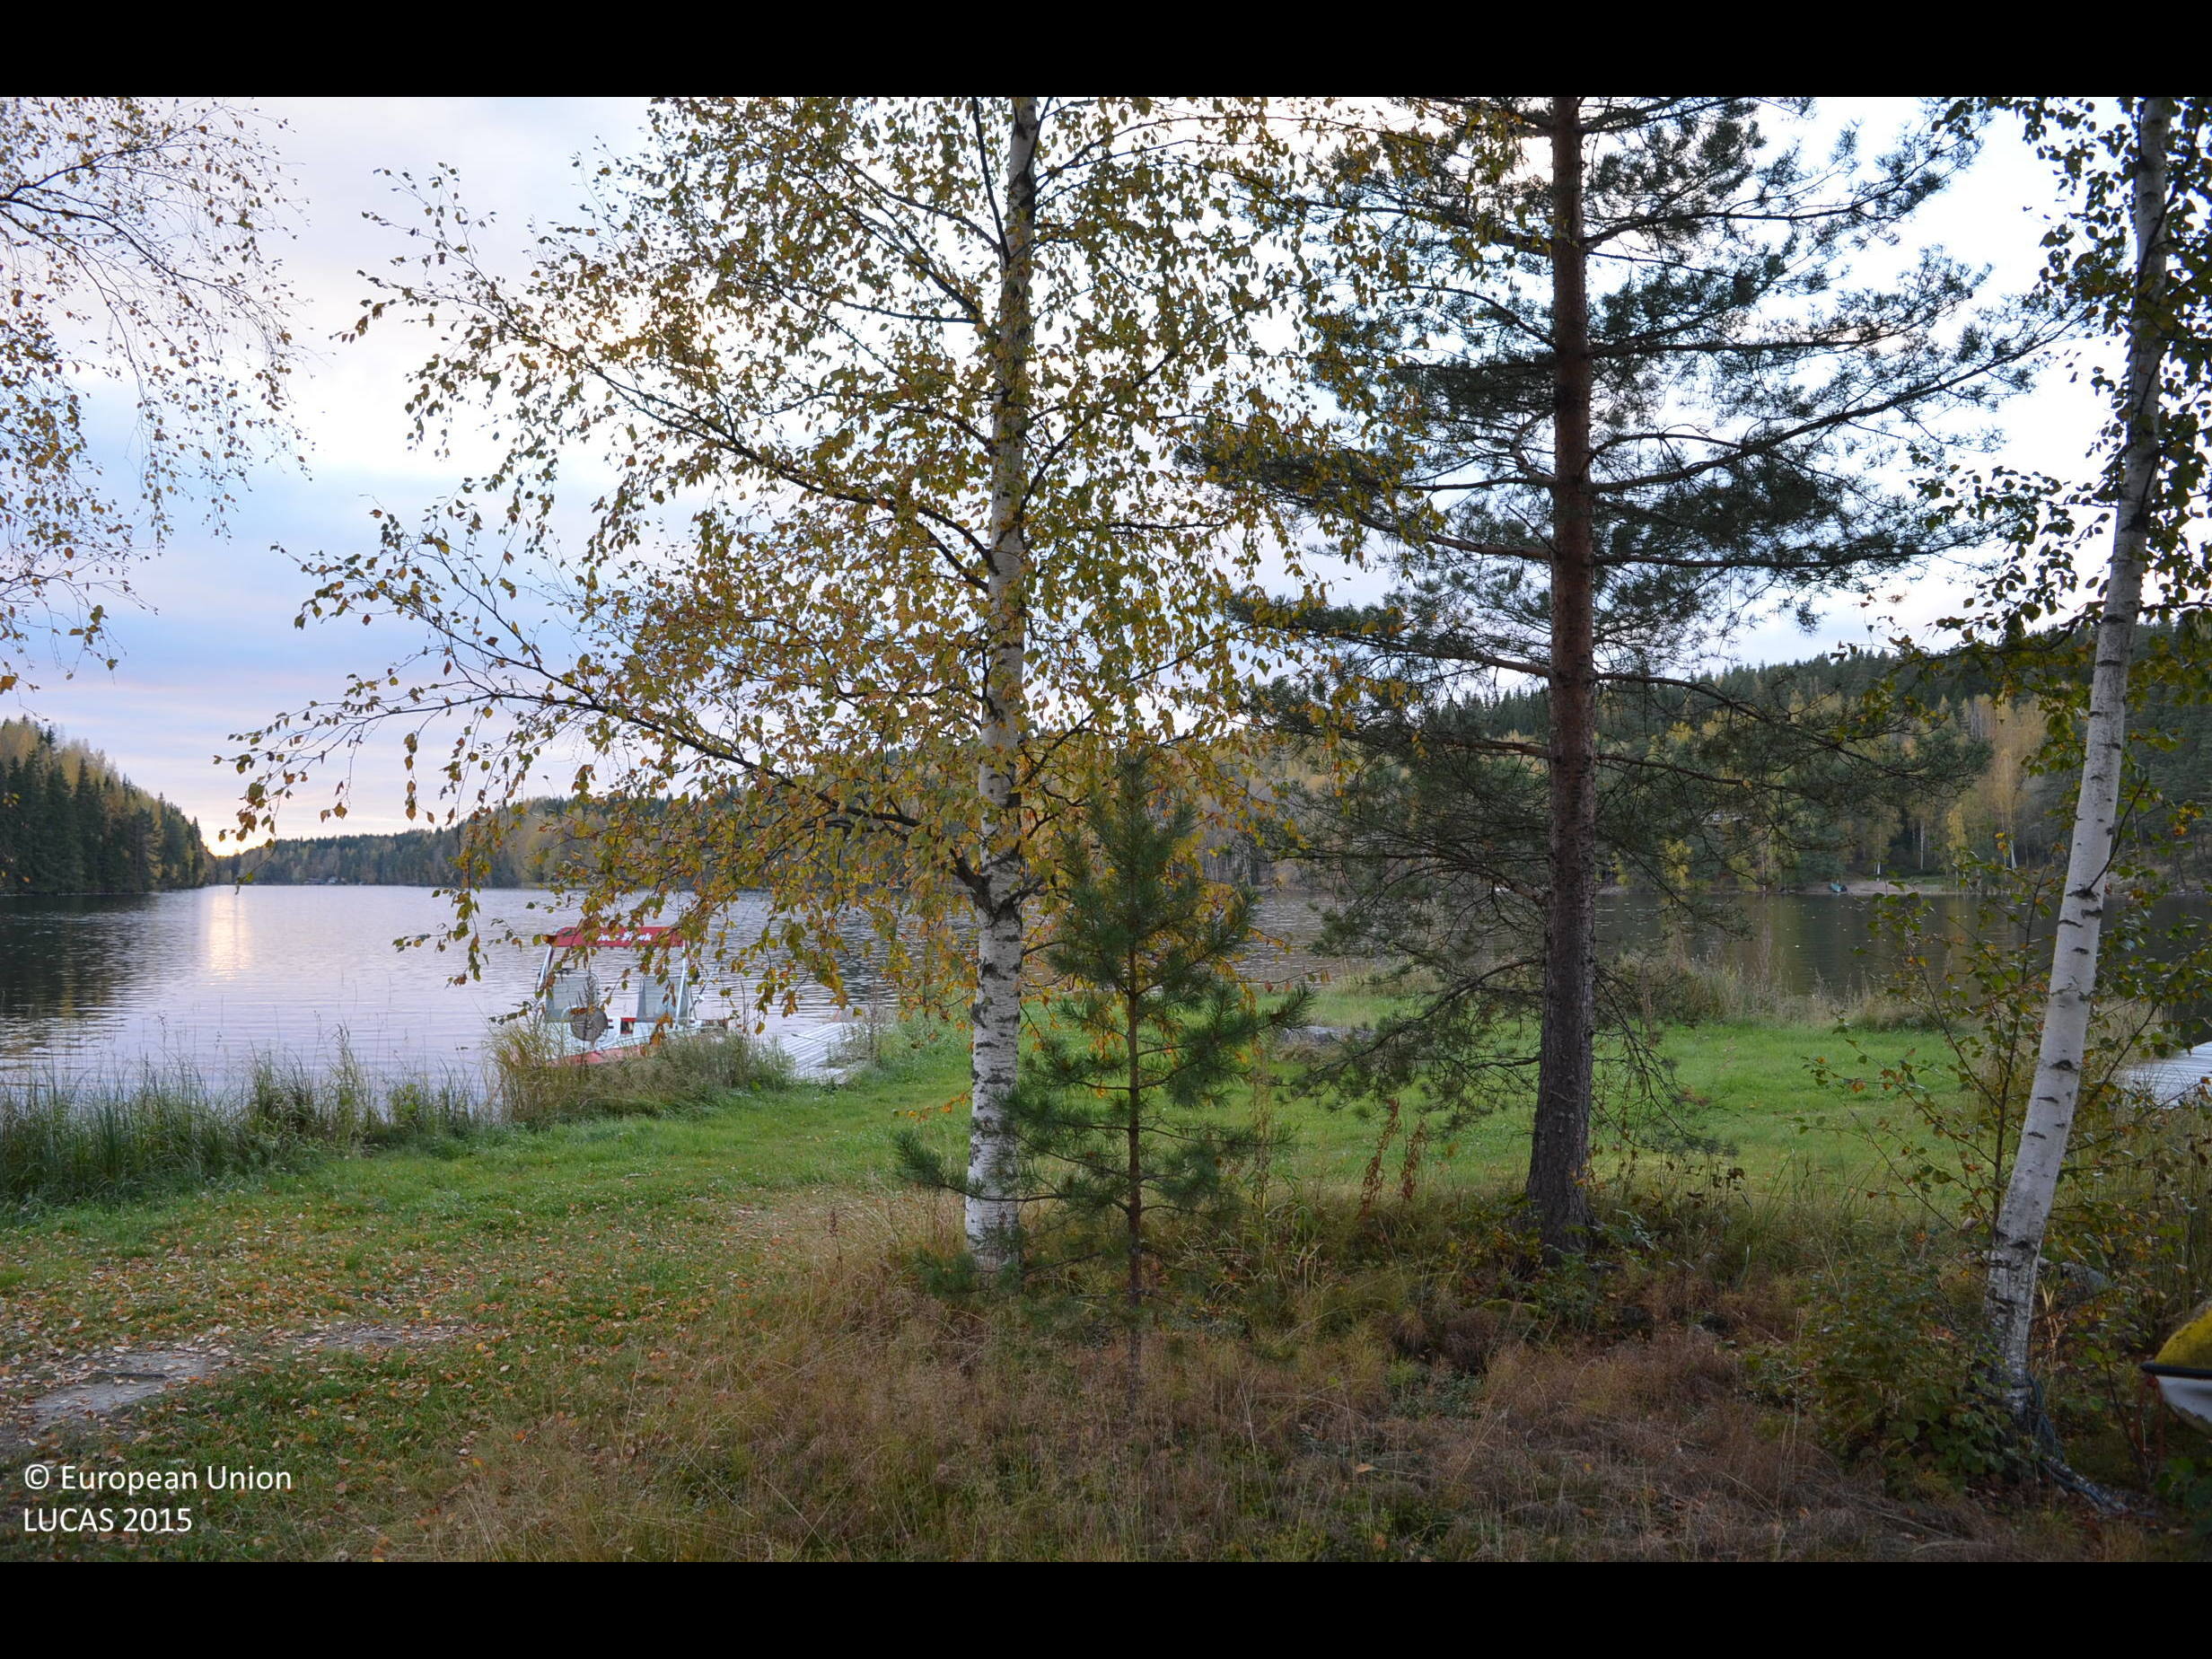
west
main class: Woodland
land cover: Other mixed woodland
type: boreal forest
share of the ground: 50 - 75 %
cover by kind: herbaceous plants 40 %, coniferous forest trees 25 %, broadleaved forest trees 25 %, shrubs 10 %
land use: Residential
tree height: > 5 m
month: October
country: FI
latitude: 61.6351
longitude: 23.8781
